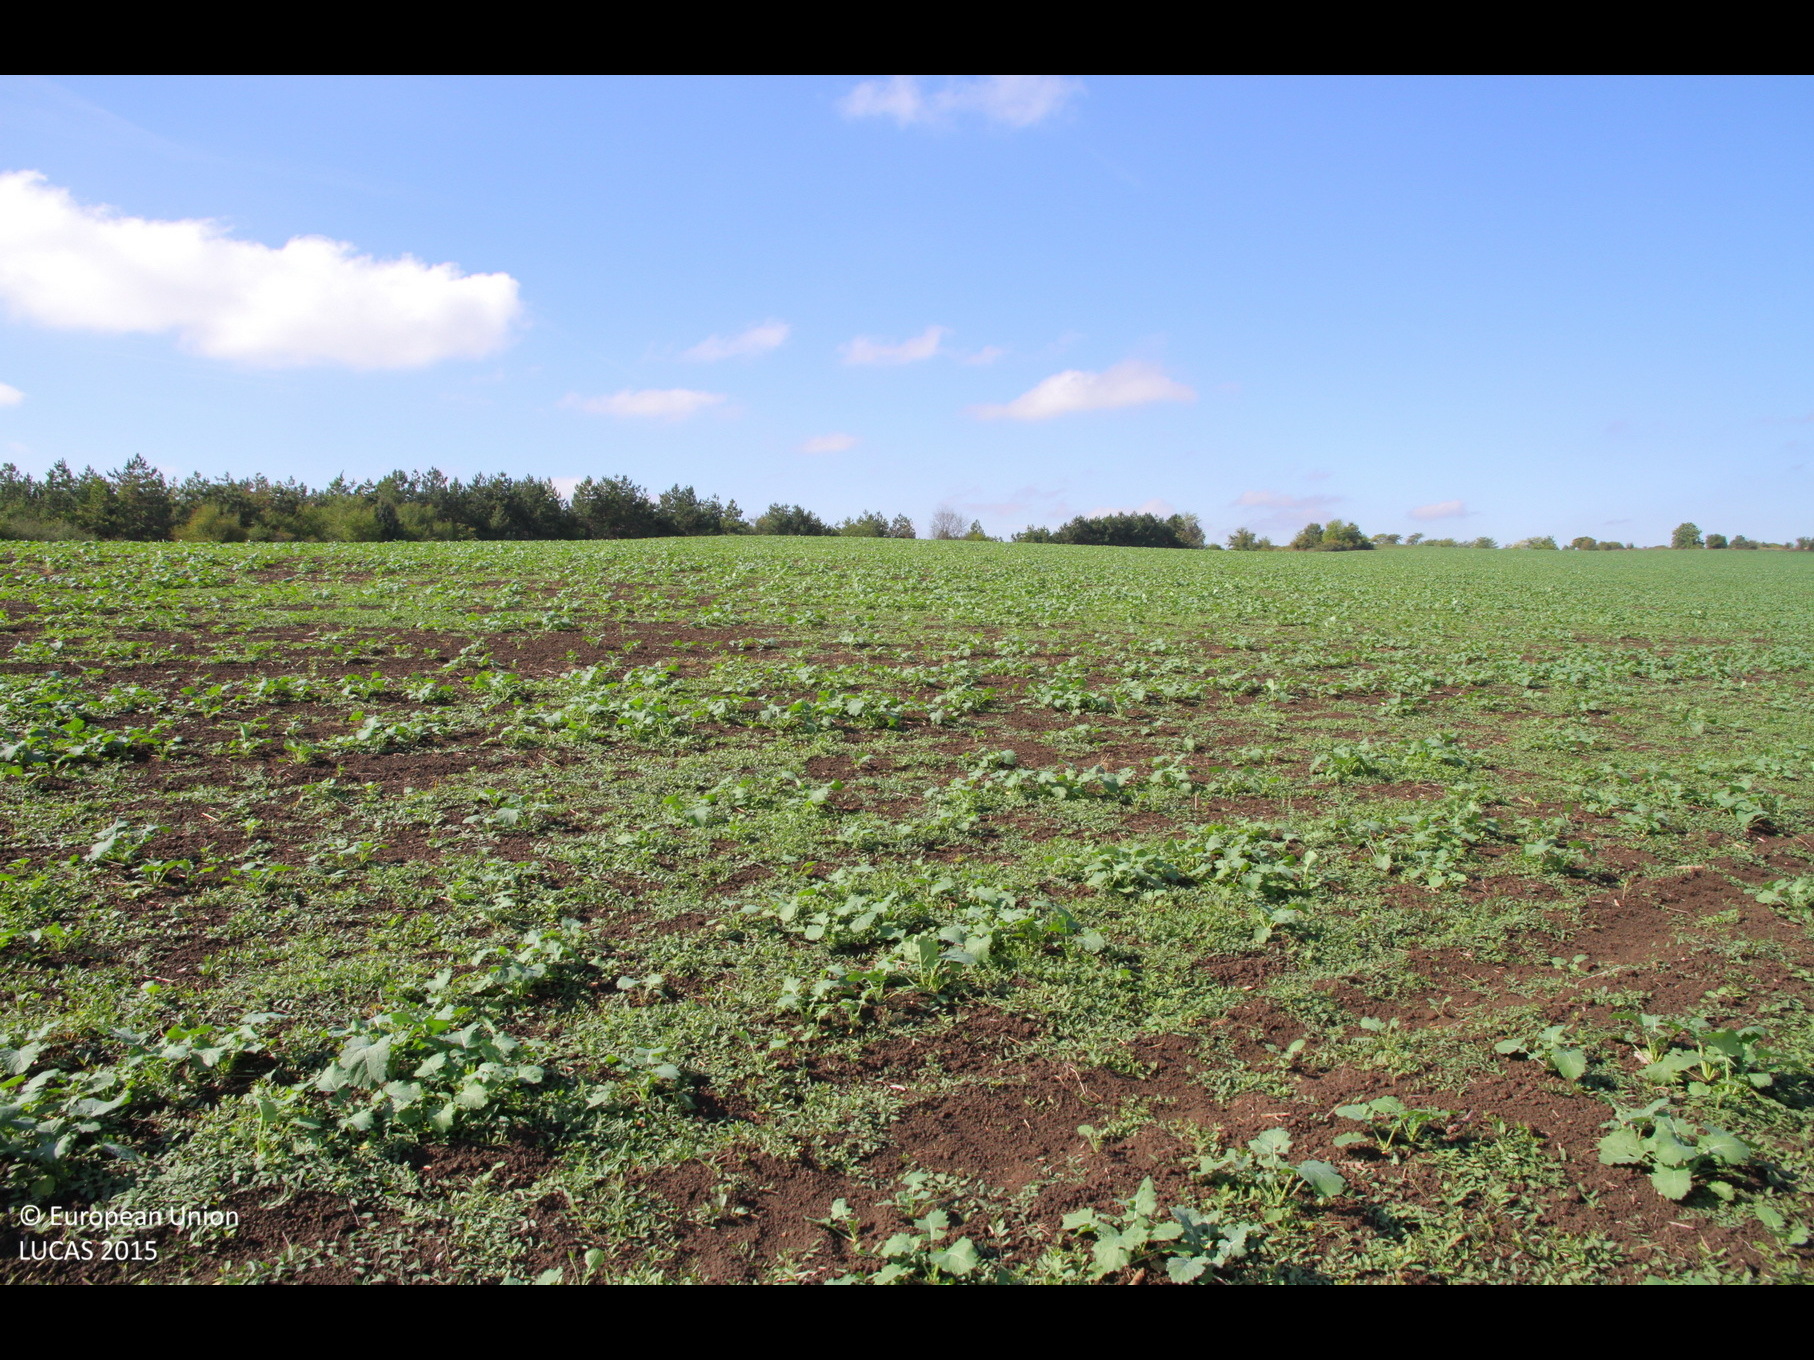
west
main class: Cropland
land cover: Rape and turnip rape
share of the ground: 25 - 50 %
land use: Agriculture (excluding fallow land and kitchen gardens)
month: October
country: BG
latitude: 43.3633
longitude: 26.5278
